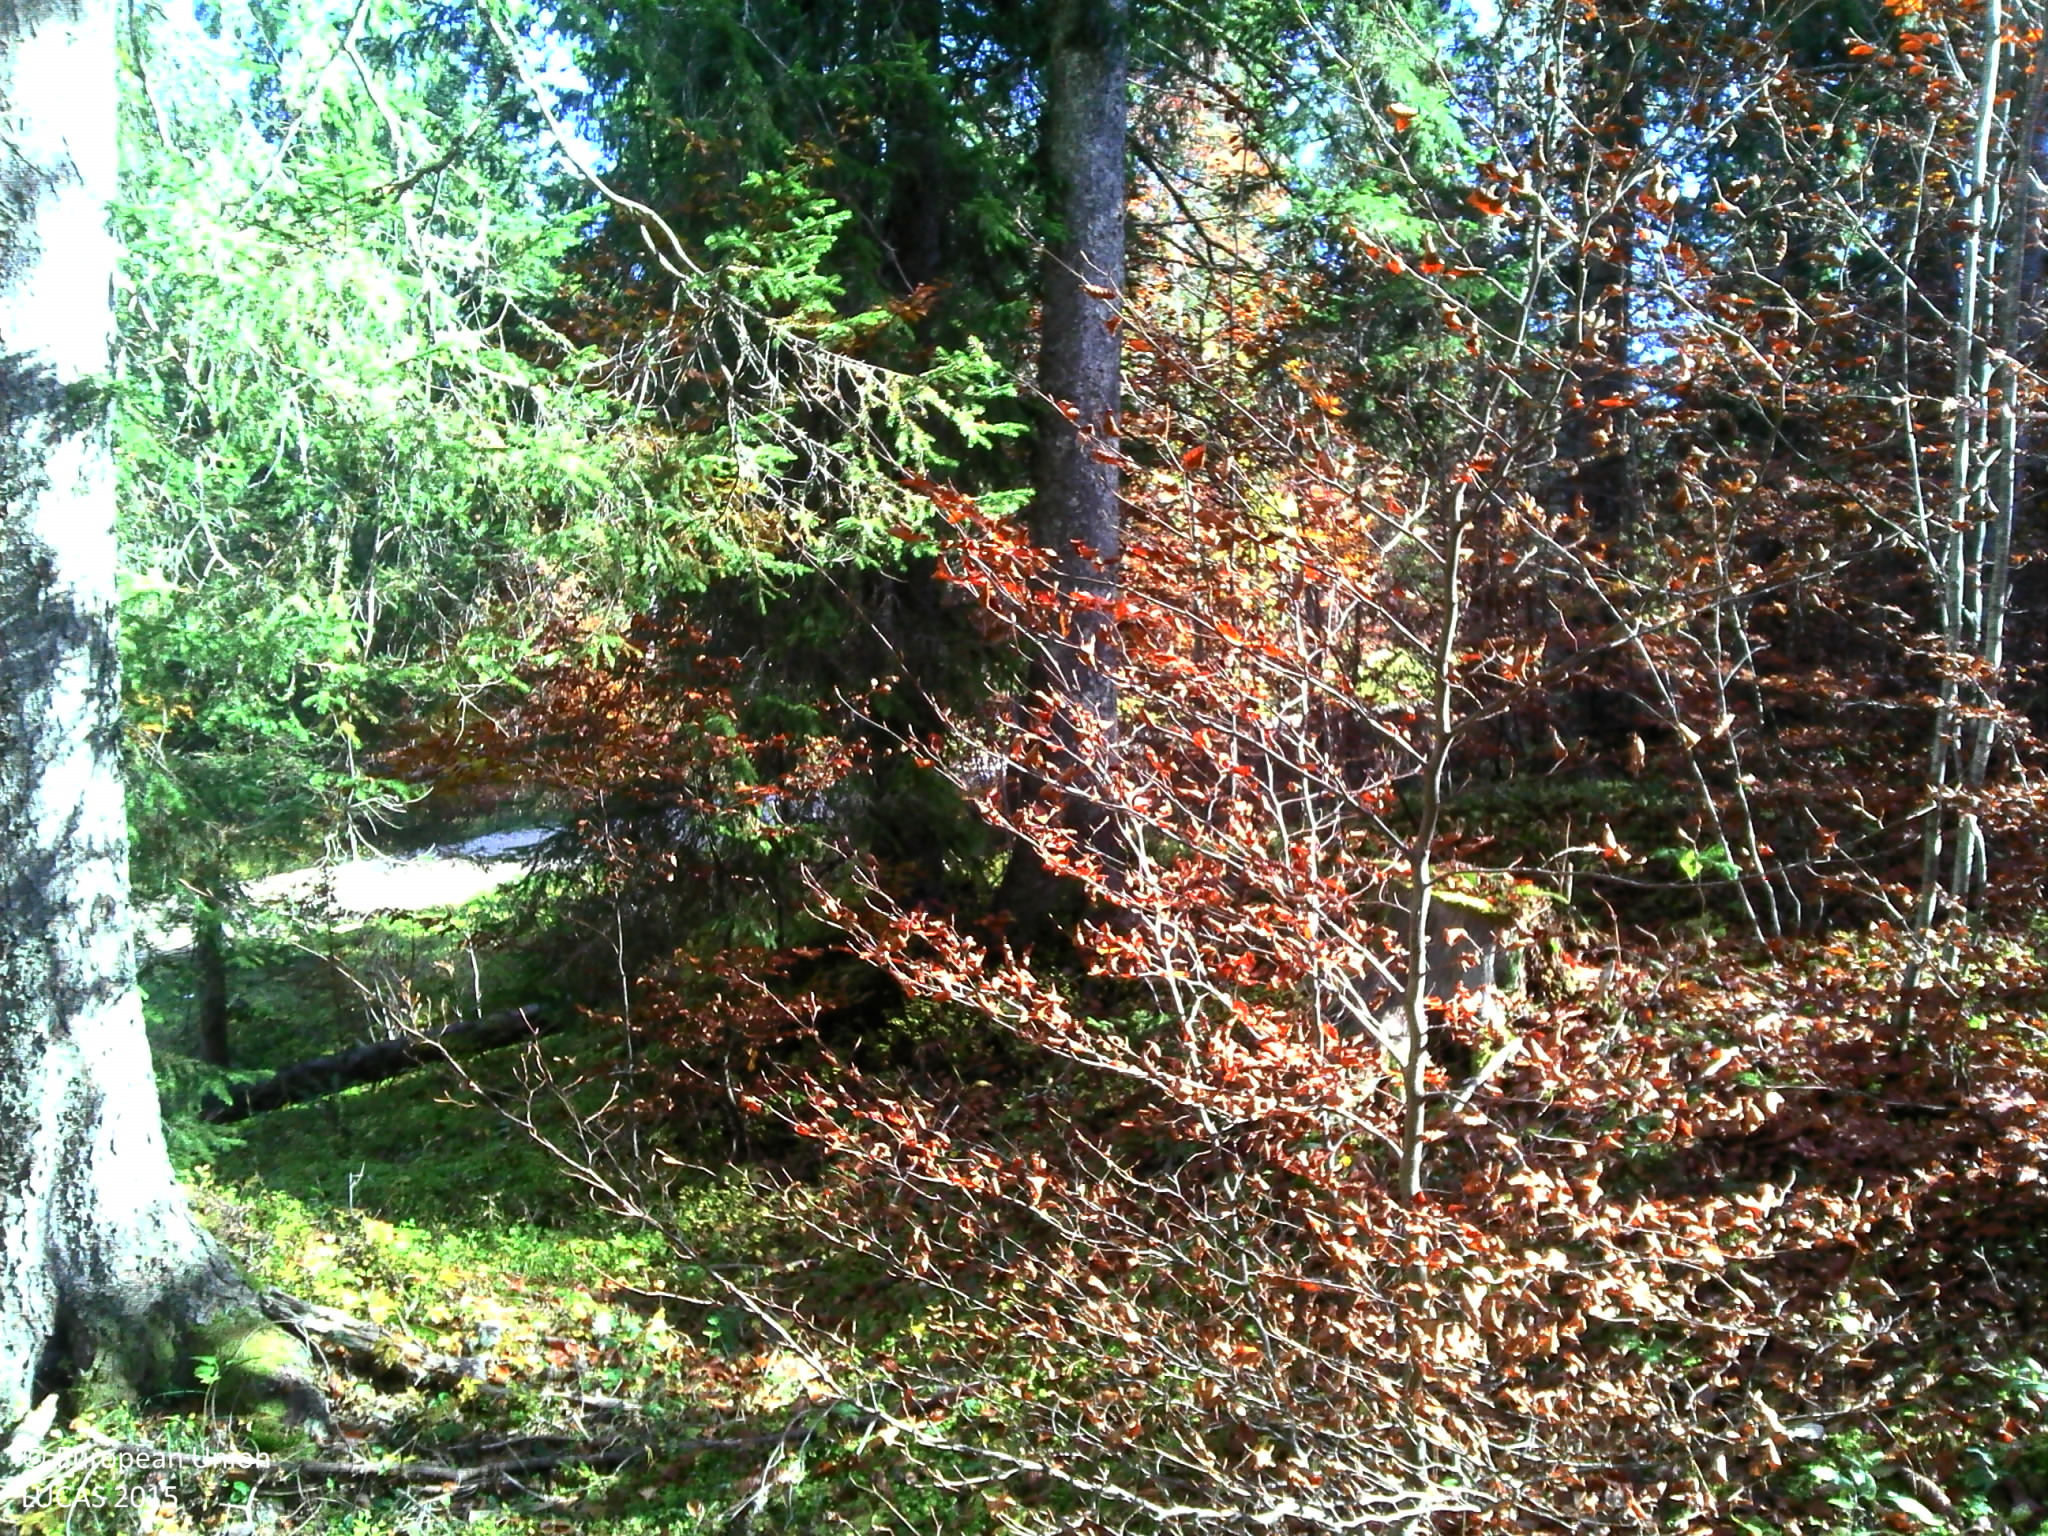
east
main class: Woodland
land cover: Spruce dominated mixed woodland
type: mountainous beech forest
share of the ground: > 75 %
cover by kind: broadleaved forest trees 40 %, coniferous forest trees 30 %, herbaceous plants 10 %, lichens and mosses 10 %, consolidated bare surface 5 %, unconsolidated bare surface 5 %
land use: Forestry
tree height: > 5 m
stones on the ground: 10 - 25 %
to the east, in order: Spruce dominated mixed woodland; Spontaneously vegetated surfaces; Paved roads, cycling and walking lanes; Spruce dominated mixed woodland; Tracks; Spruce dominated mixed woodland; Tracks; Spruce dominated mixed woodland; Dry stone walls; Spruce dominated mixed woodland
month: October
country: FR
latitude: 46.6245
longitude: 6.1501
